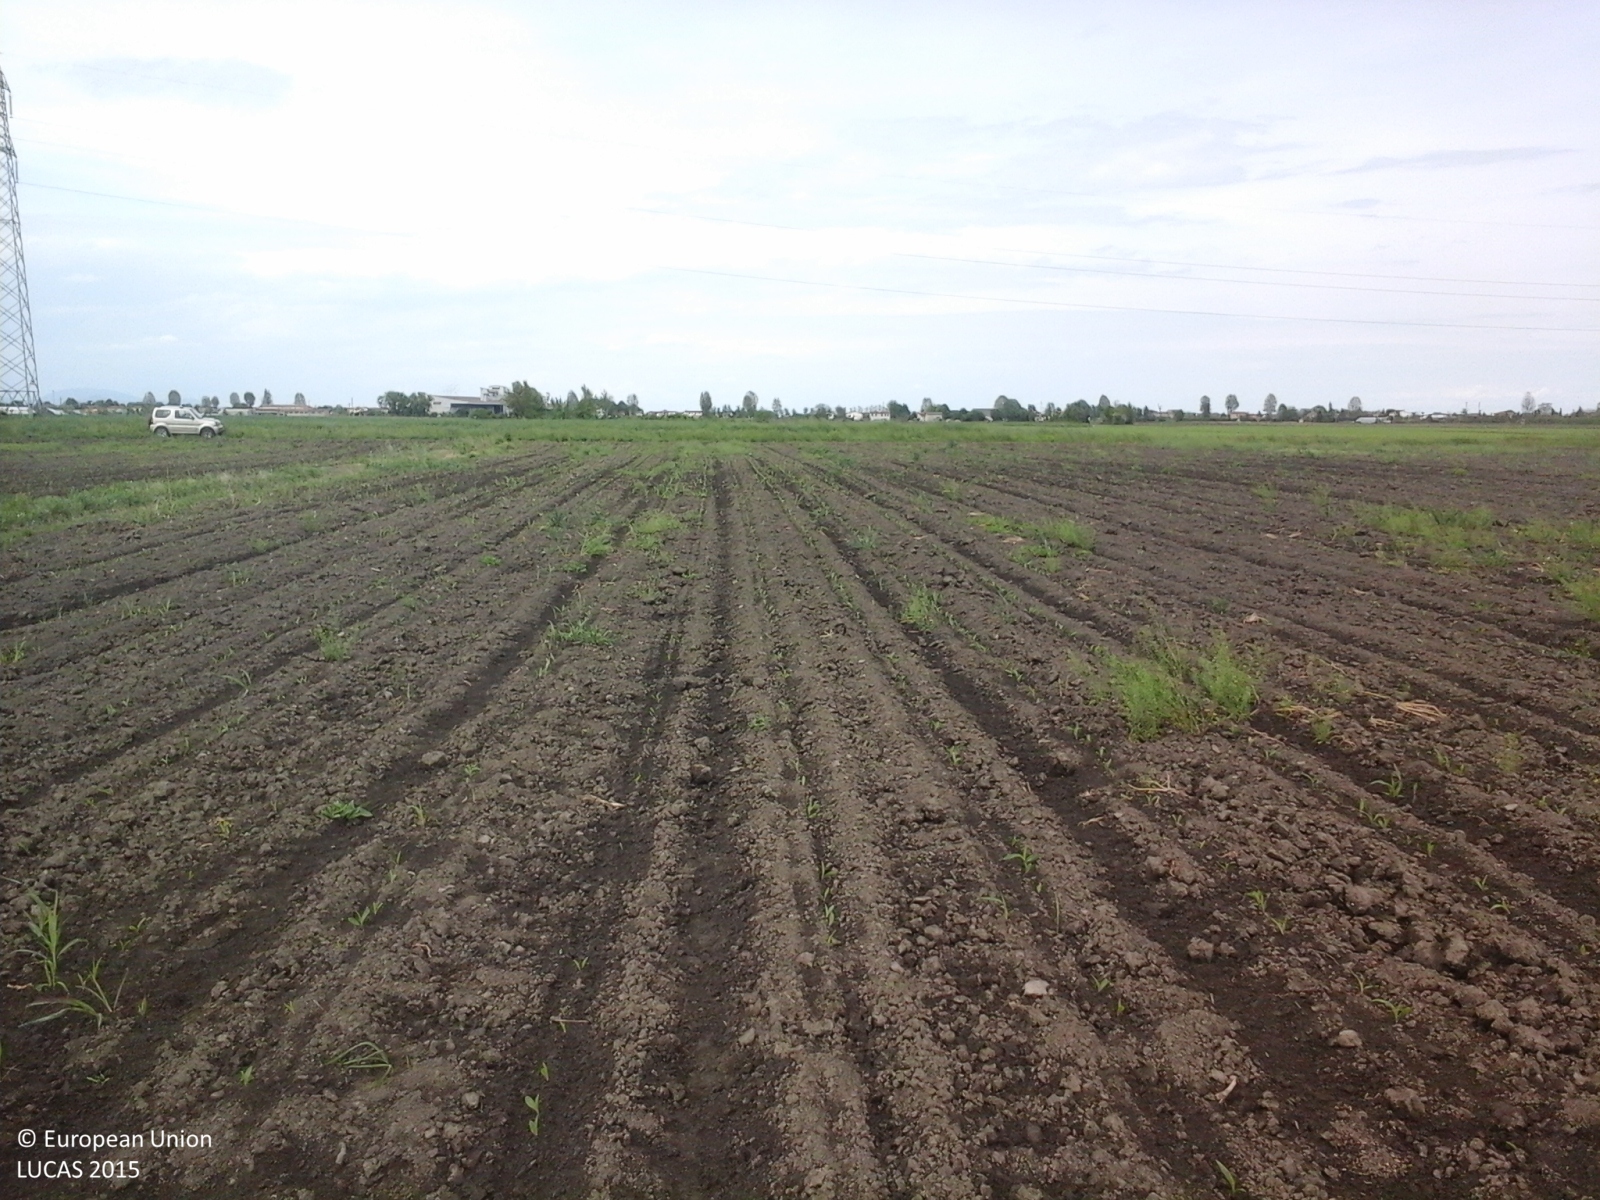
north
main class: Cropland
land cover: Maize
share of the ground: < 10 %
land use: Agriculture (excluding fallow land and kitchen gardens)
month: April
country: IT
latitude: 45.0544
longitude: 11.9139
